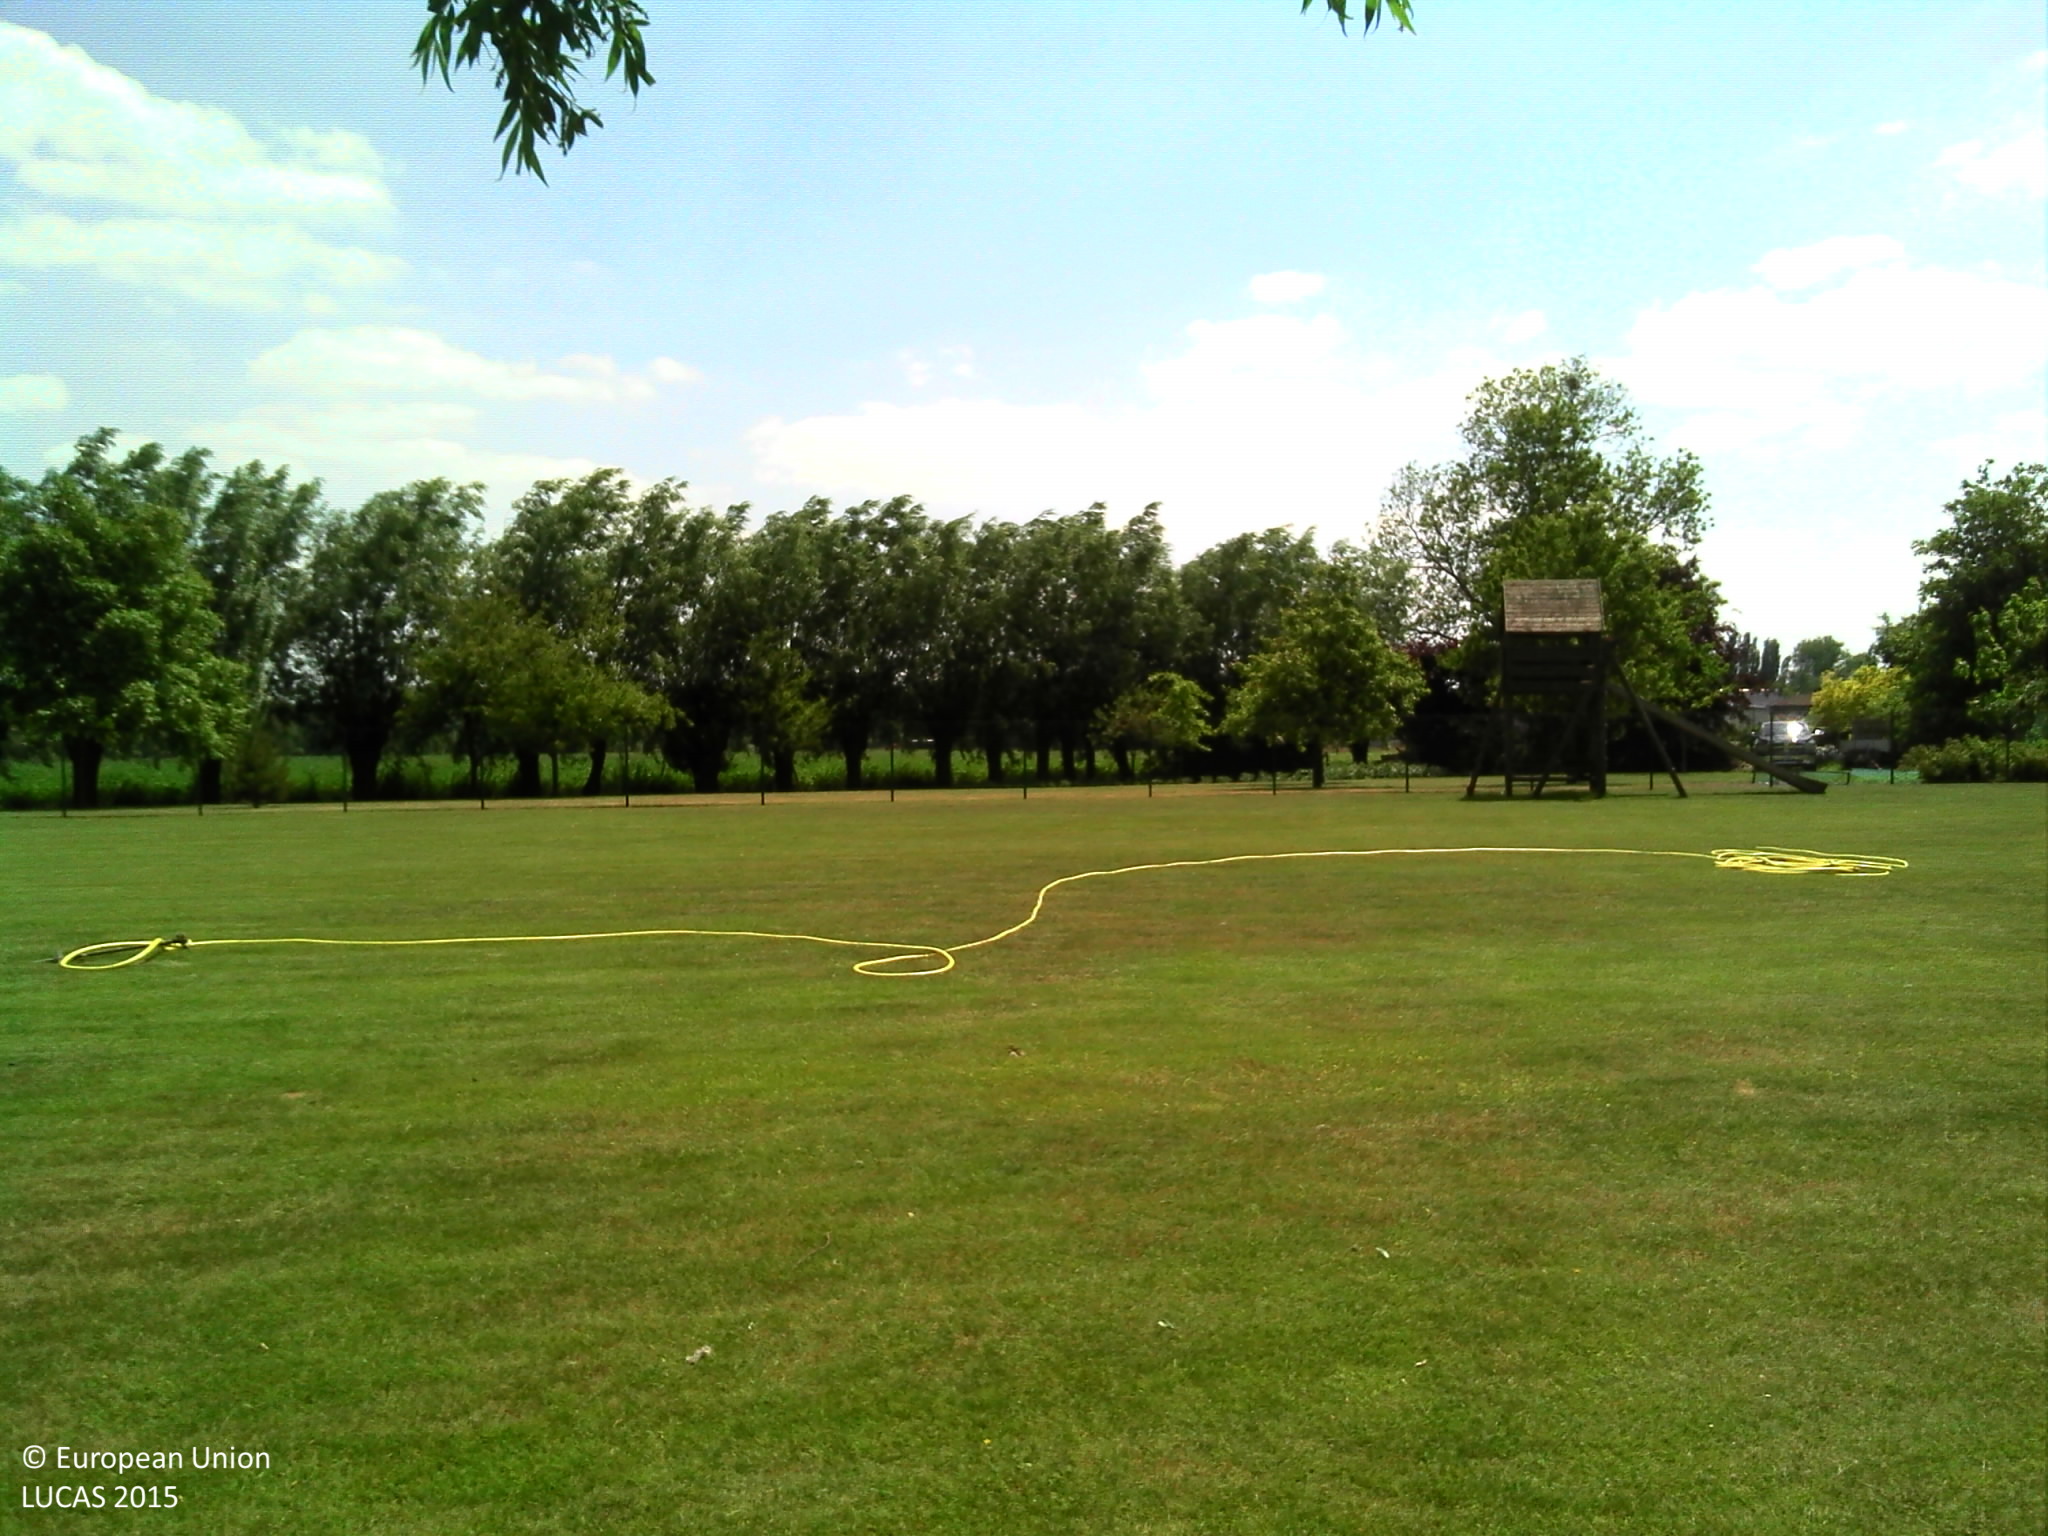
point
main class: Grassland
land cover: Grassland without tree/shrub cover
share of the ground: > 75 %
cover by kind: herbaceous plants 100 %
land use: Residential
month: June
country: BE
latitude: 51.0489
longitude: 3.9027
